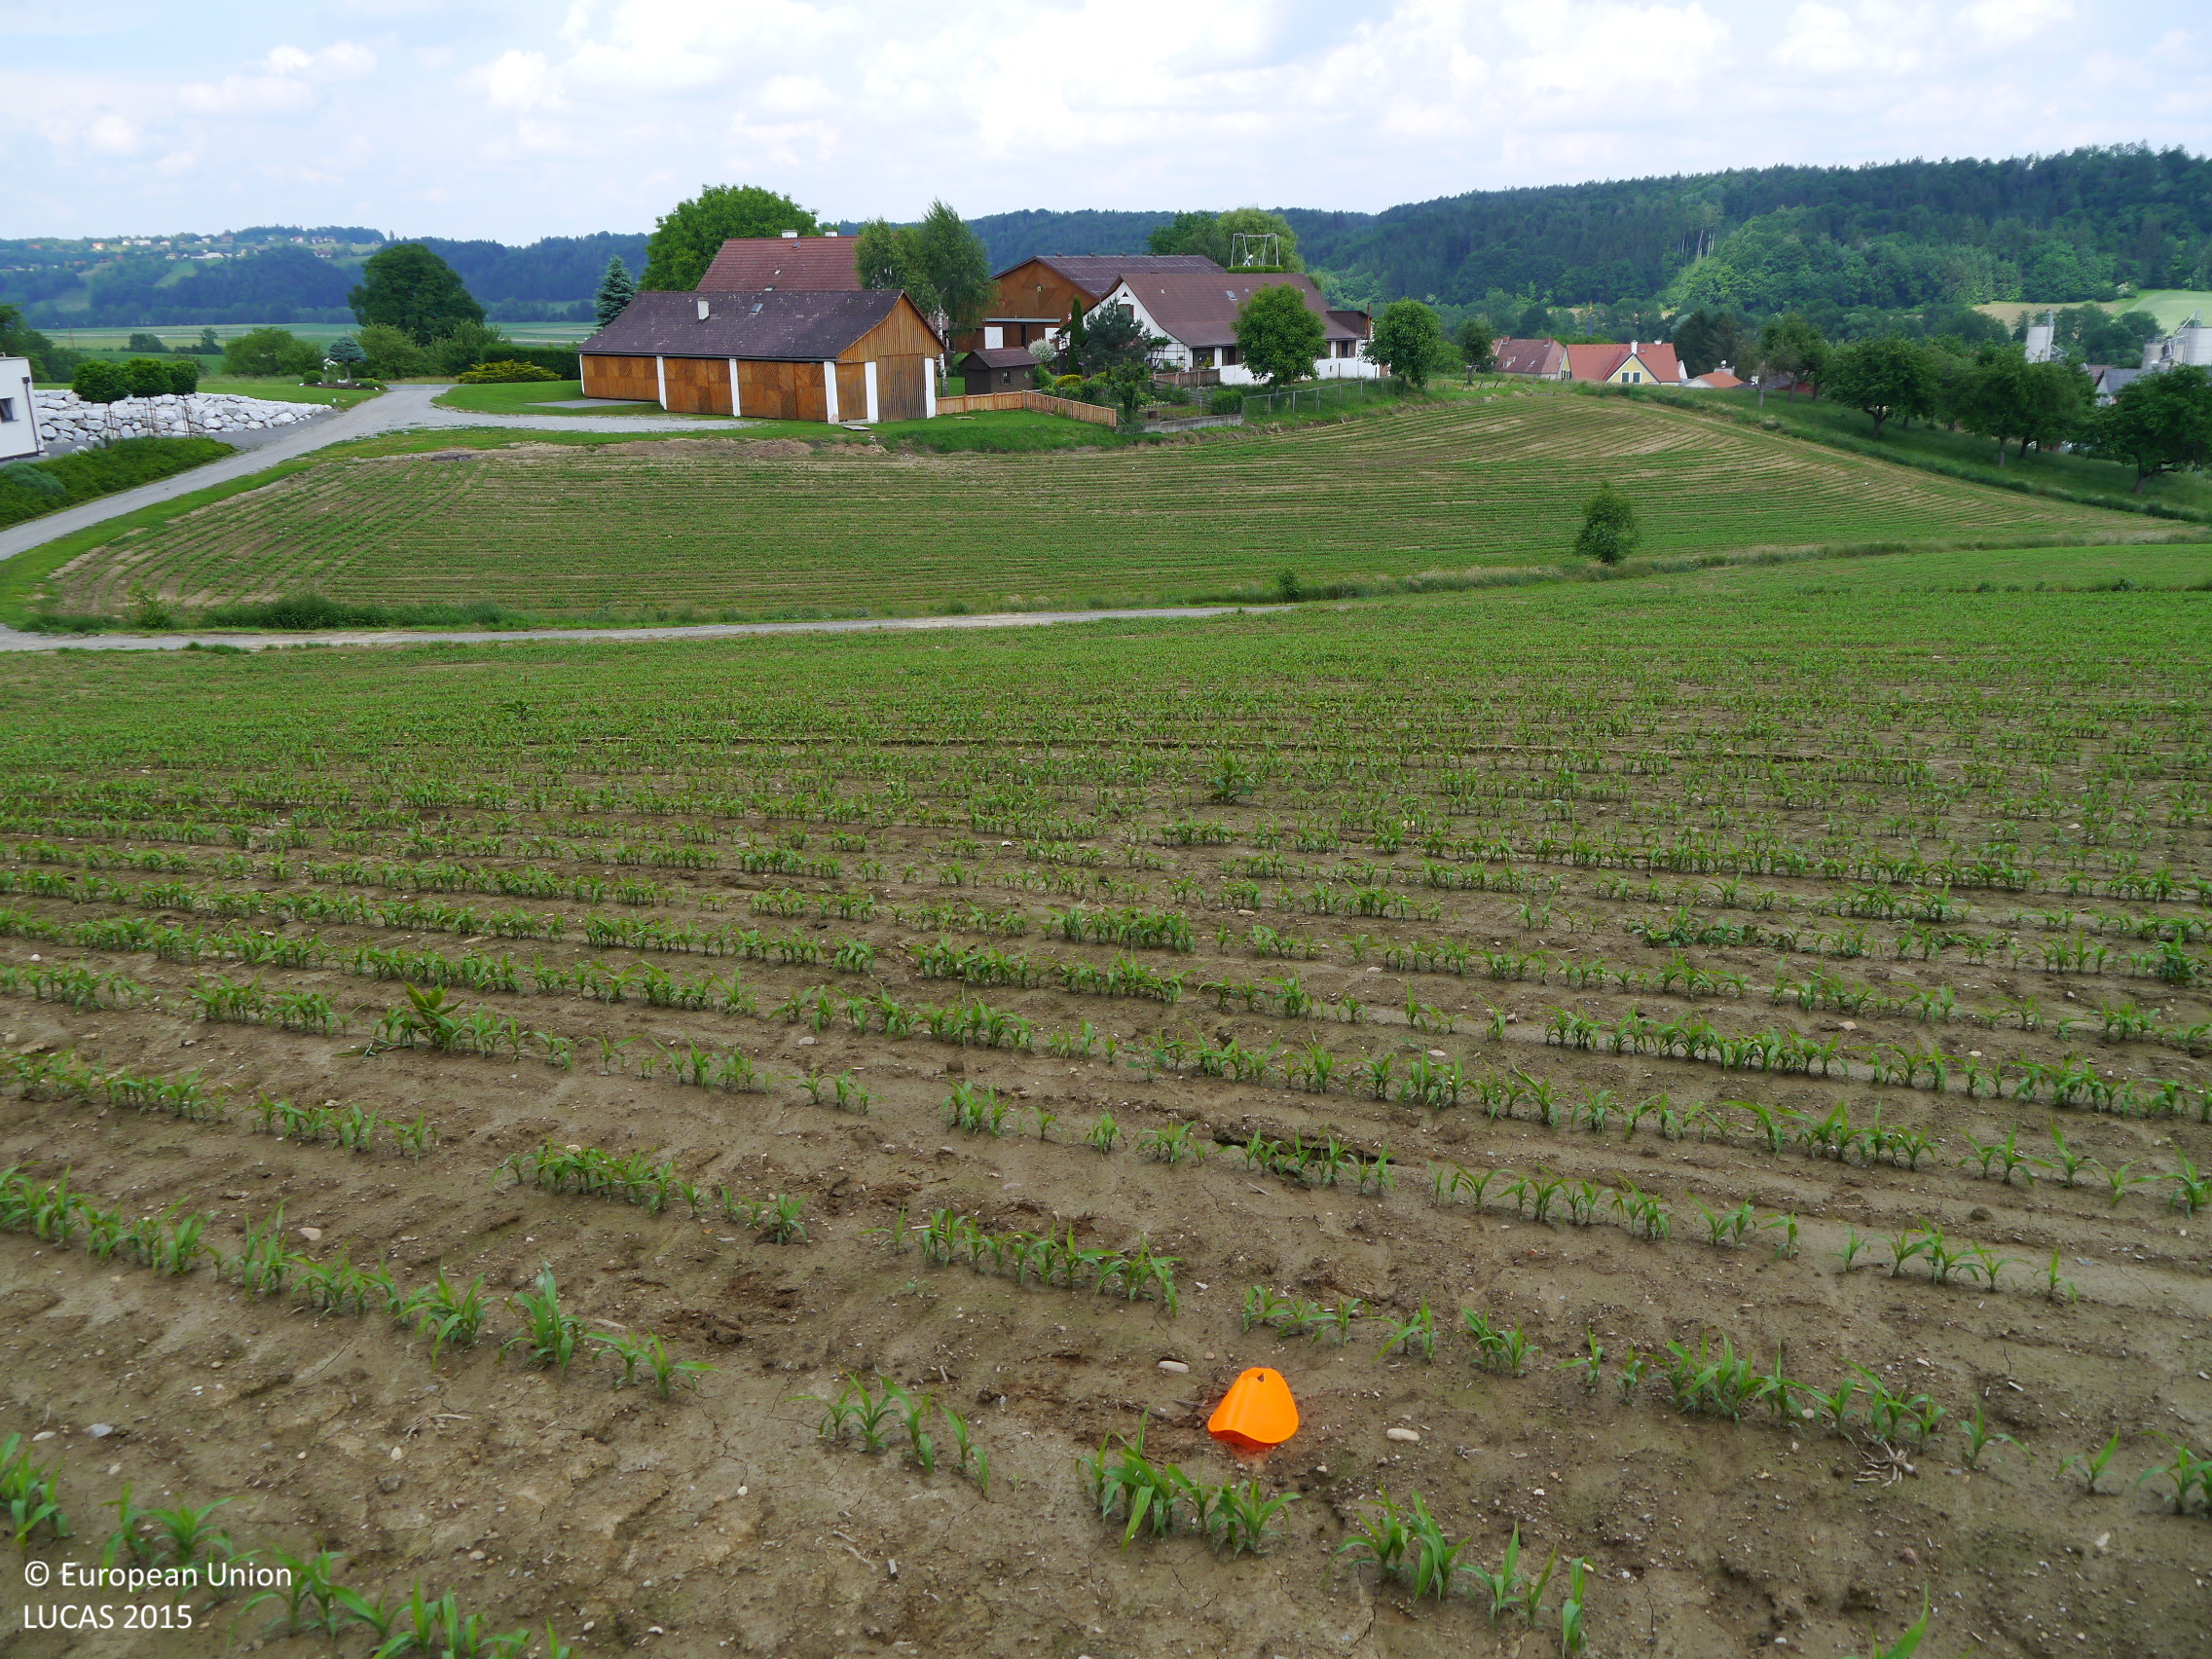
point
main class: Cropland
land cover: Maize
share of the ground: 10 - 25 %
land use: Agriculture (excluding fallow land and kitchen gardens)
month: June
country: AT
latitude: 46.8889
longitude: 15.6301
